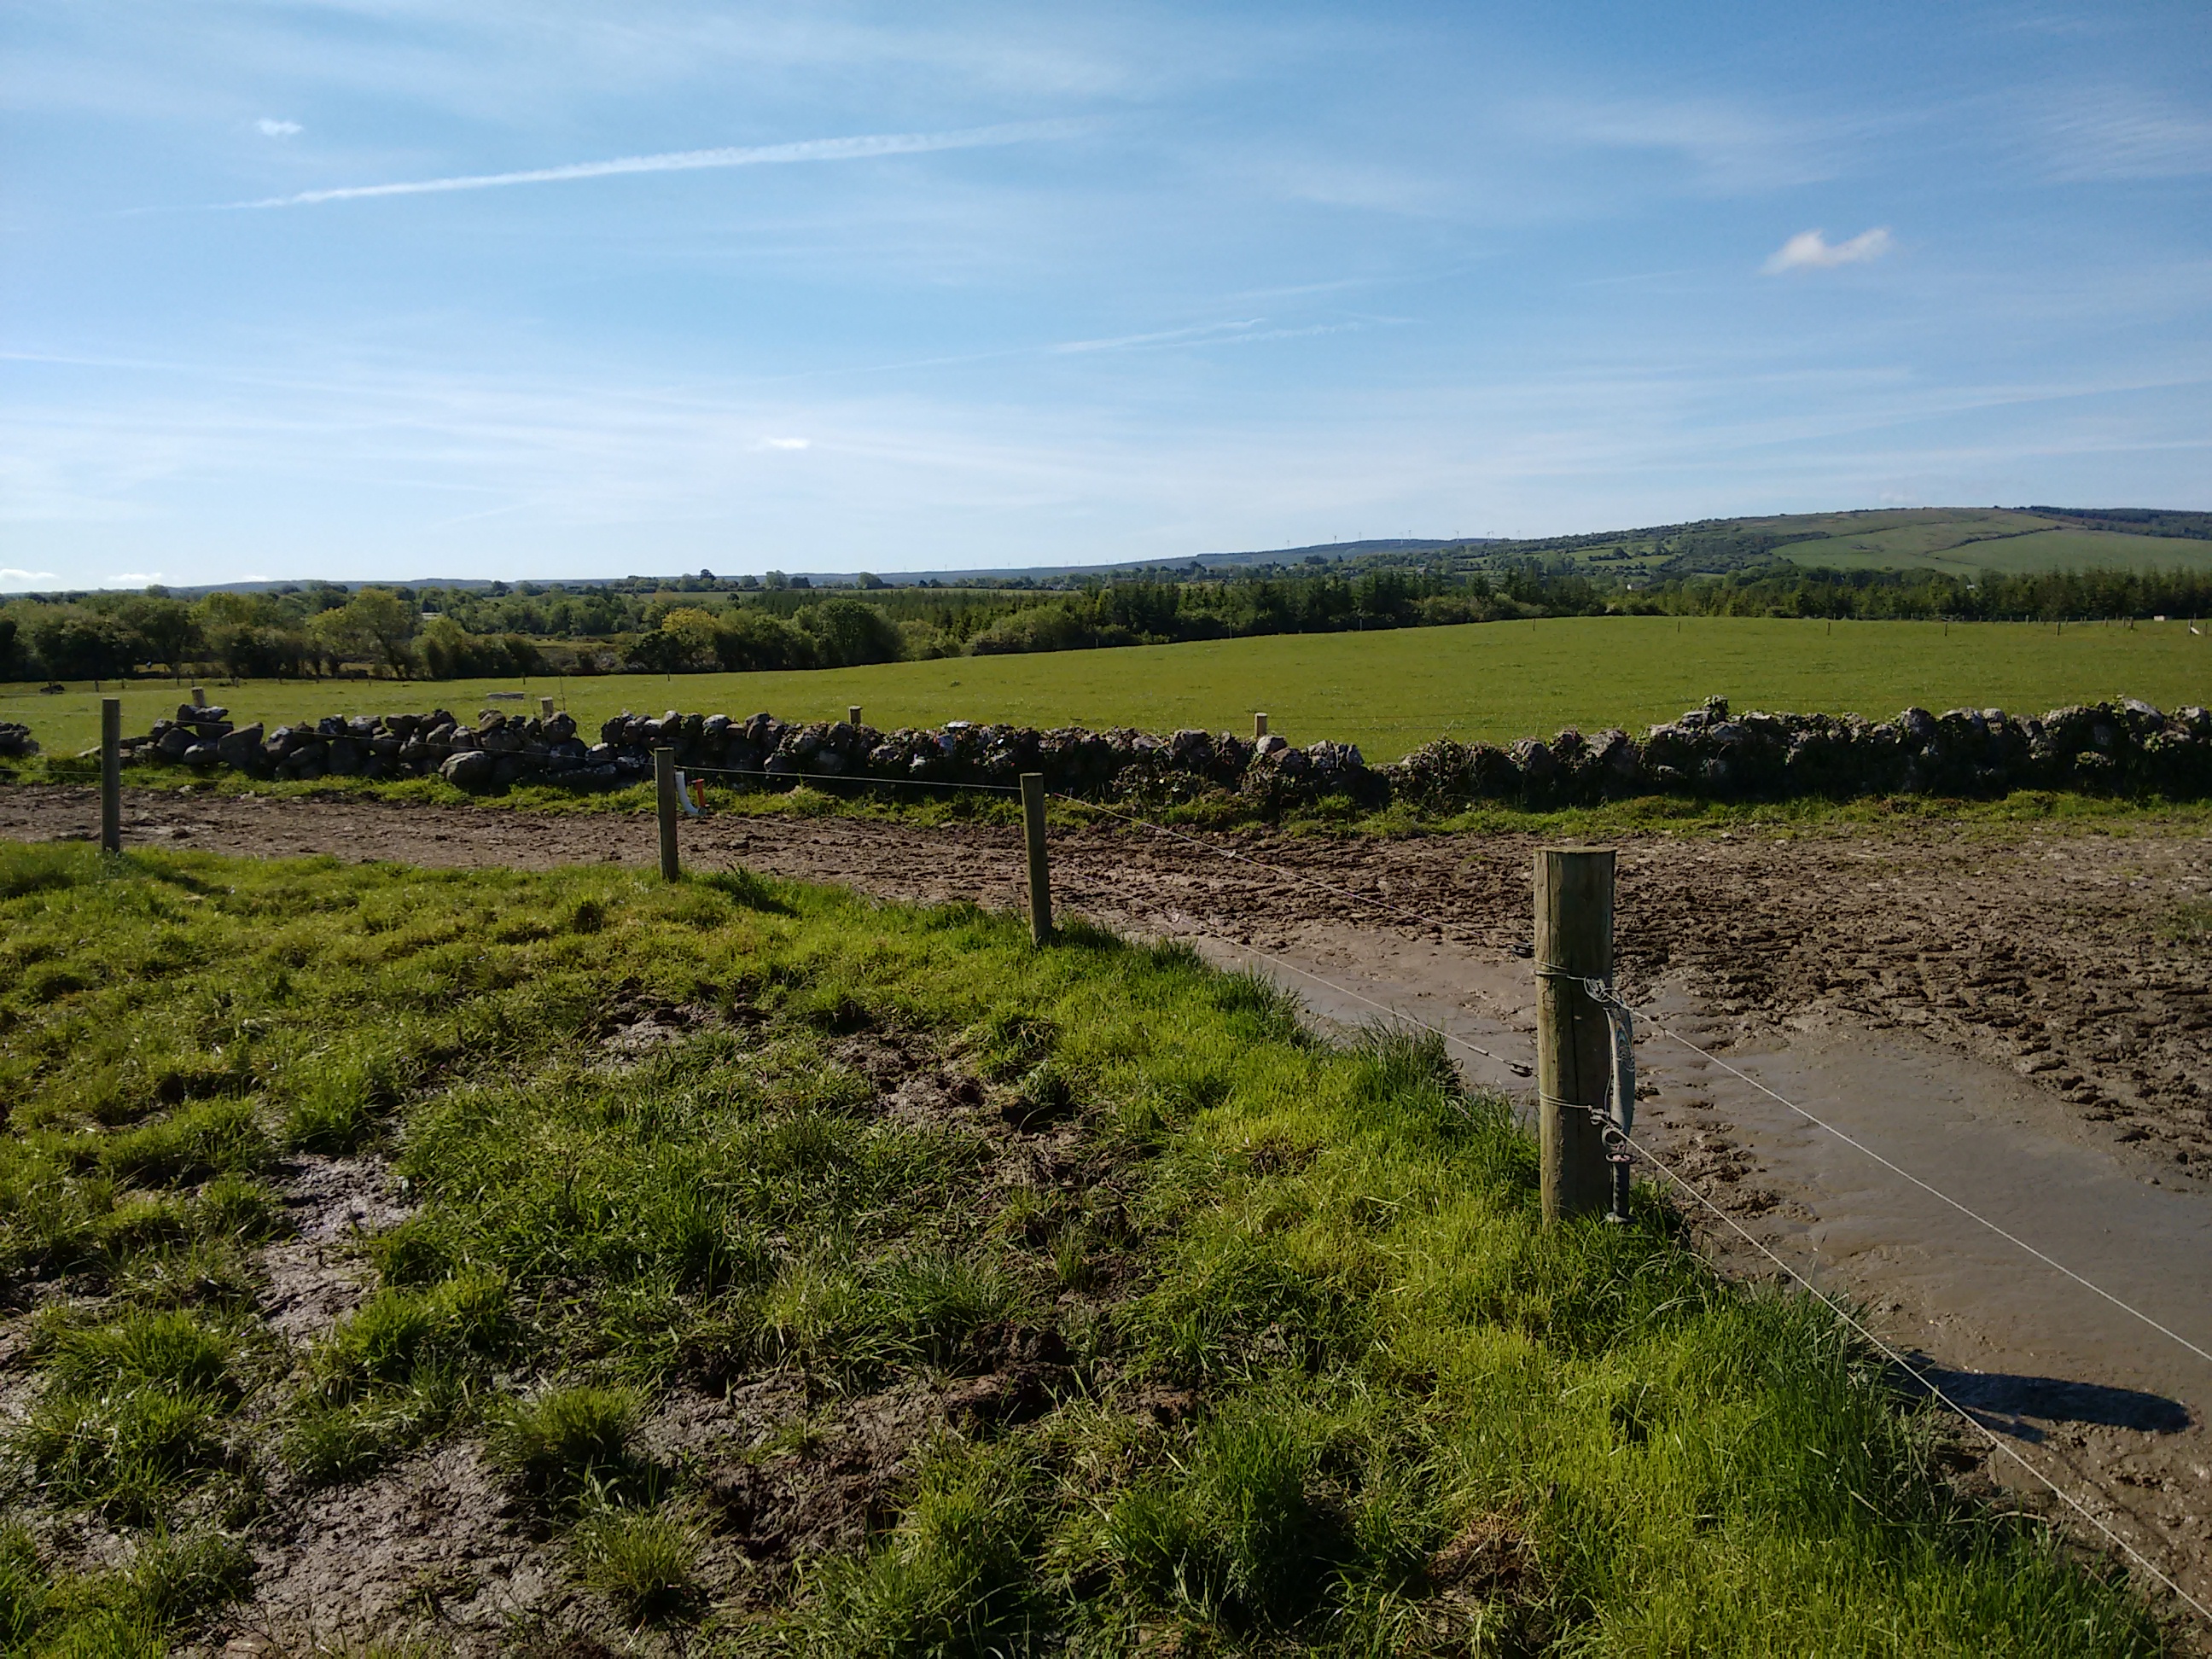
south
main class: Grassland
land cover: Grassland without tree/shrub cover
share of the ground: > 75 %
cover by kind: herbaceous plants 100 %
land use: Agriculture (excluding fallow land and kitchen gardens)
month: June
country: IE
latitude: 53.1902
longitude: -8.6530
